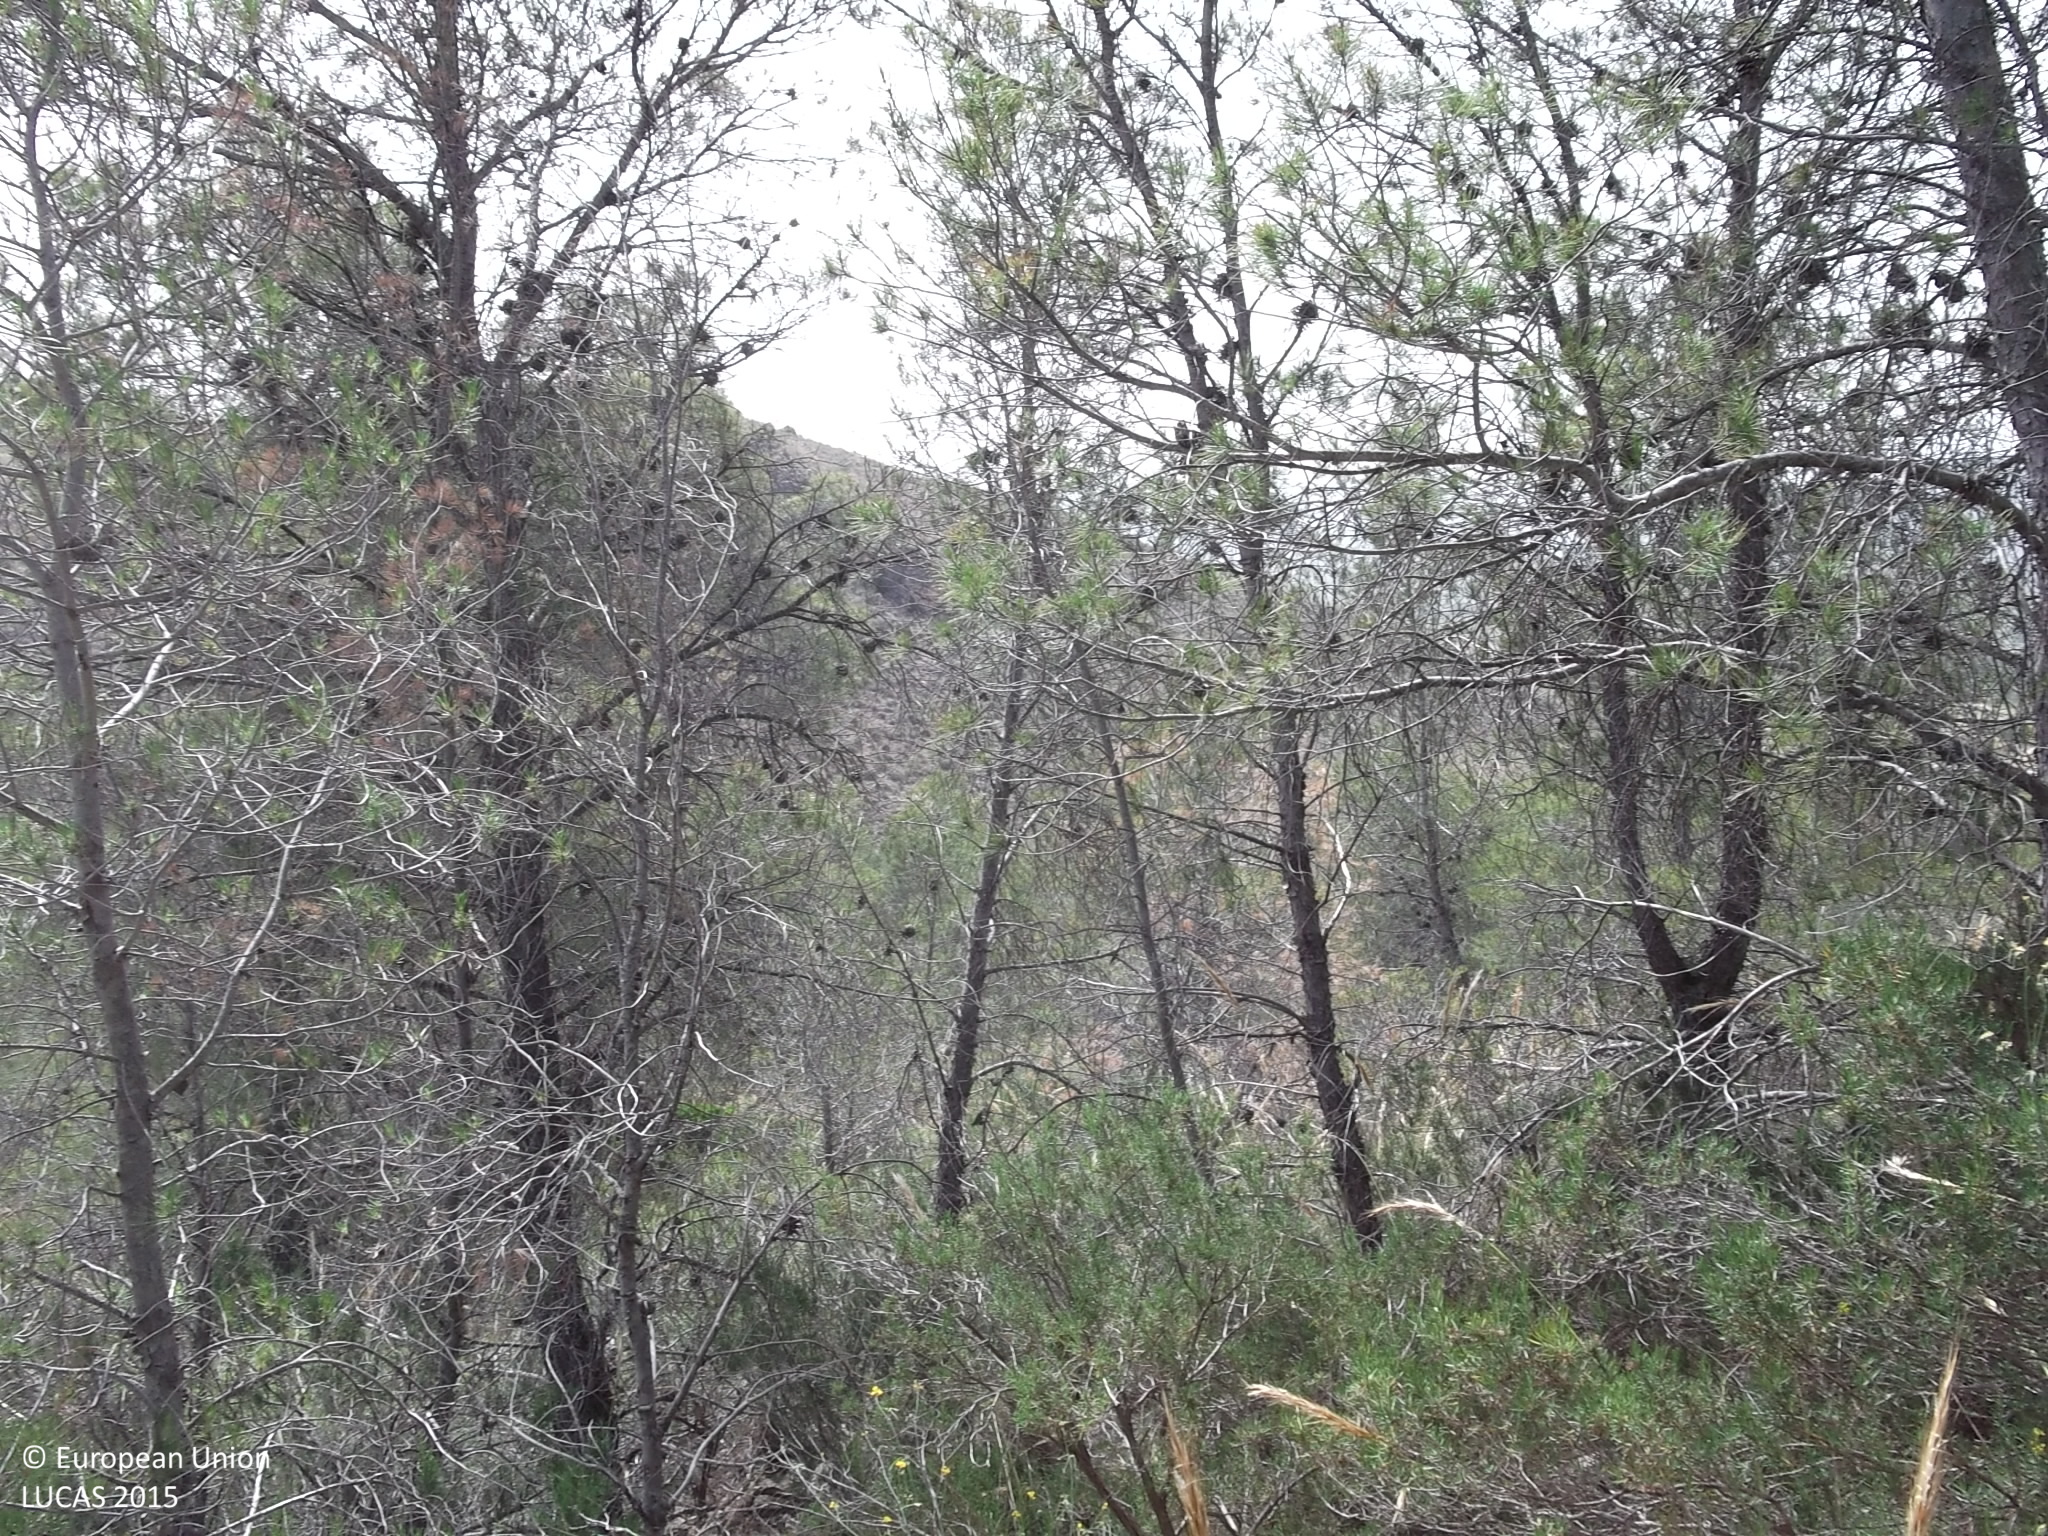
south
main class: Woodland
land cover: Pine dominated coniferous woodland
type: coniferous forest of the mediterranean region
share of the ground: 25 - 50 %
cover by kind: coniferous forest trees 35 %, shrubs 35 %, herbaceous plants 20 %, consolidated bare surface 10 %
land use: Semi-natural and natural areas not in use
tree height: > 5 m
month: May
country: ES
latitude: 38.4358
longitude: -1.6661
